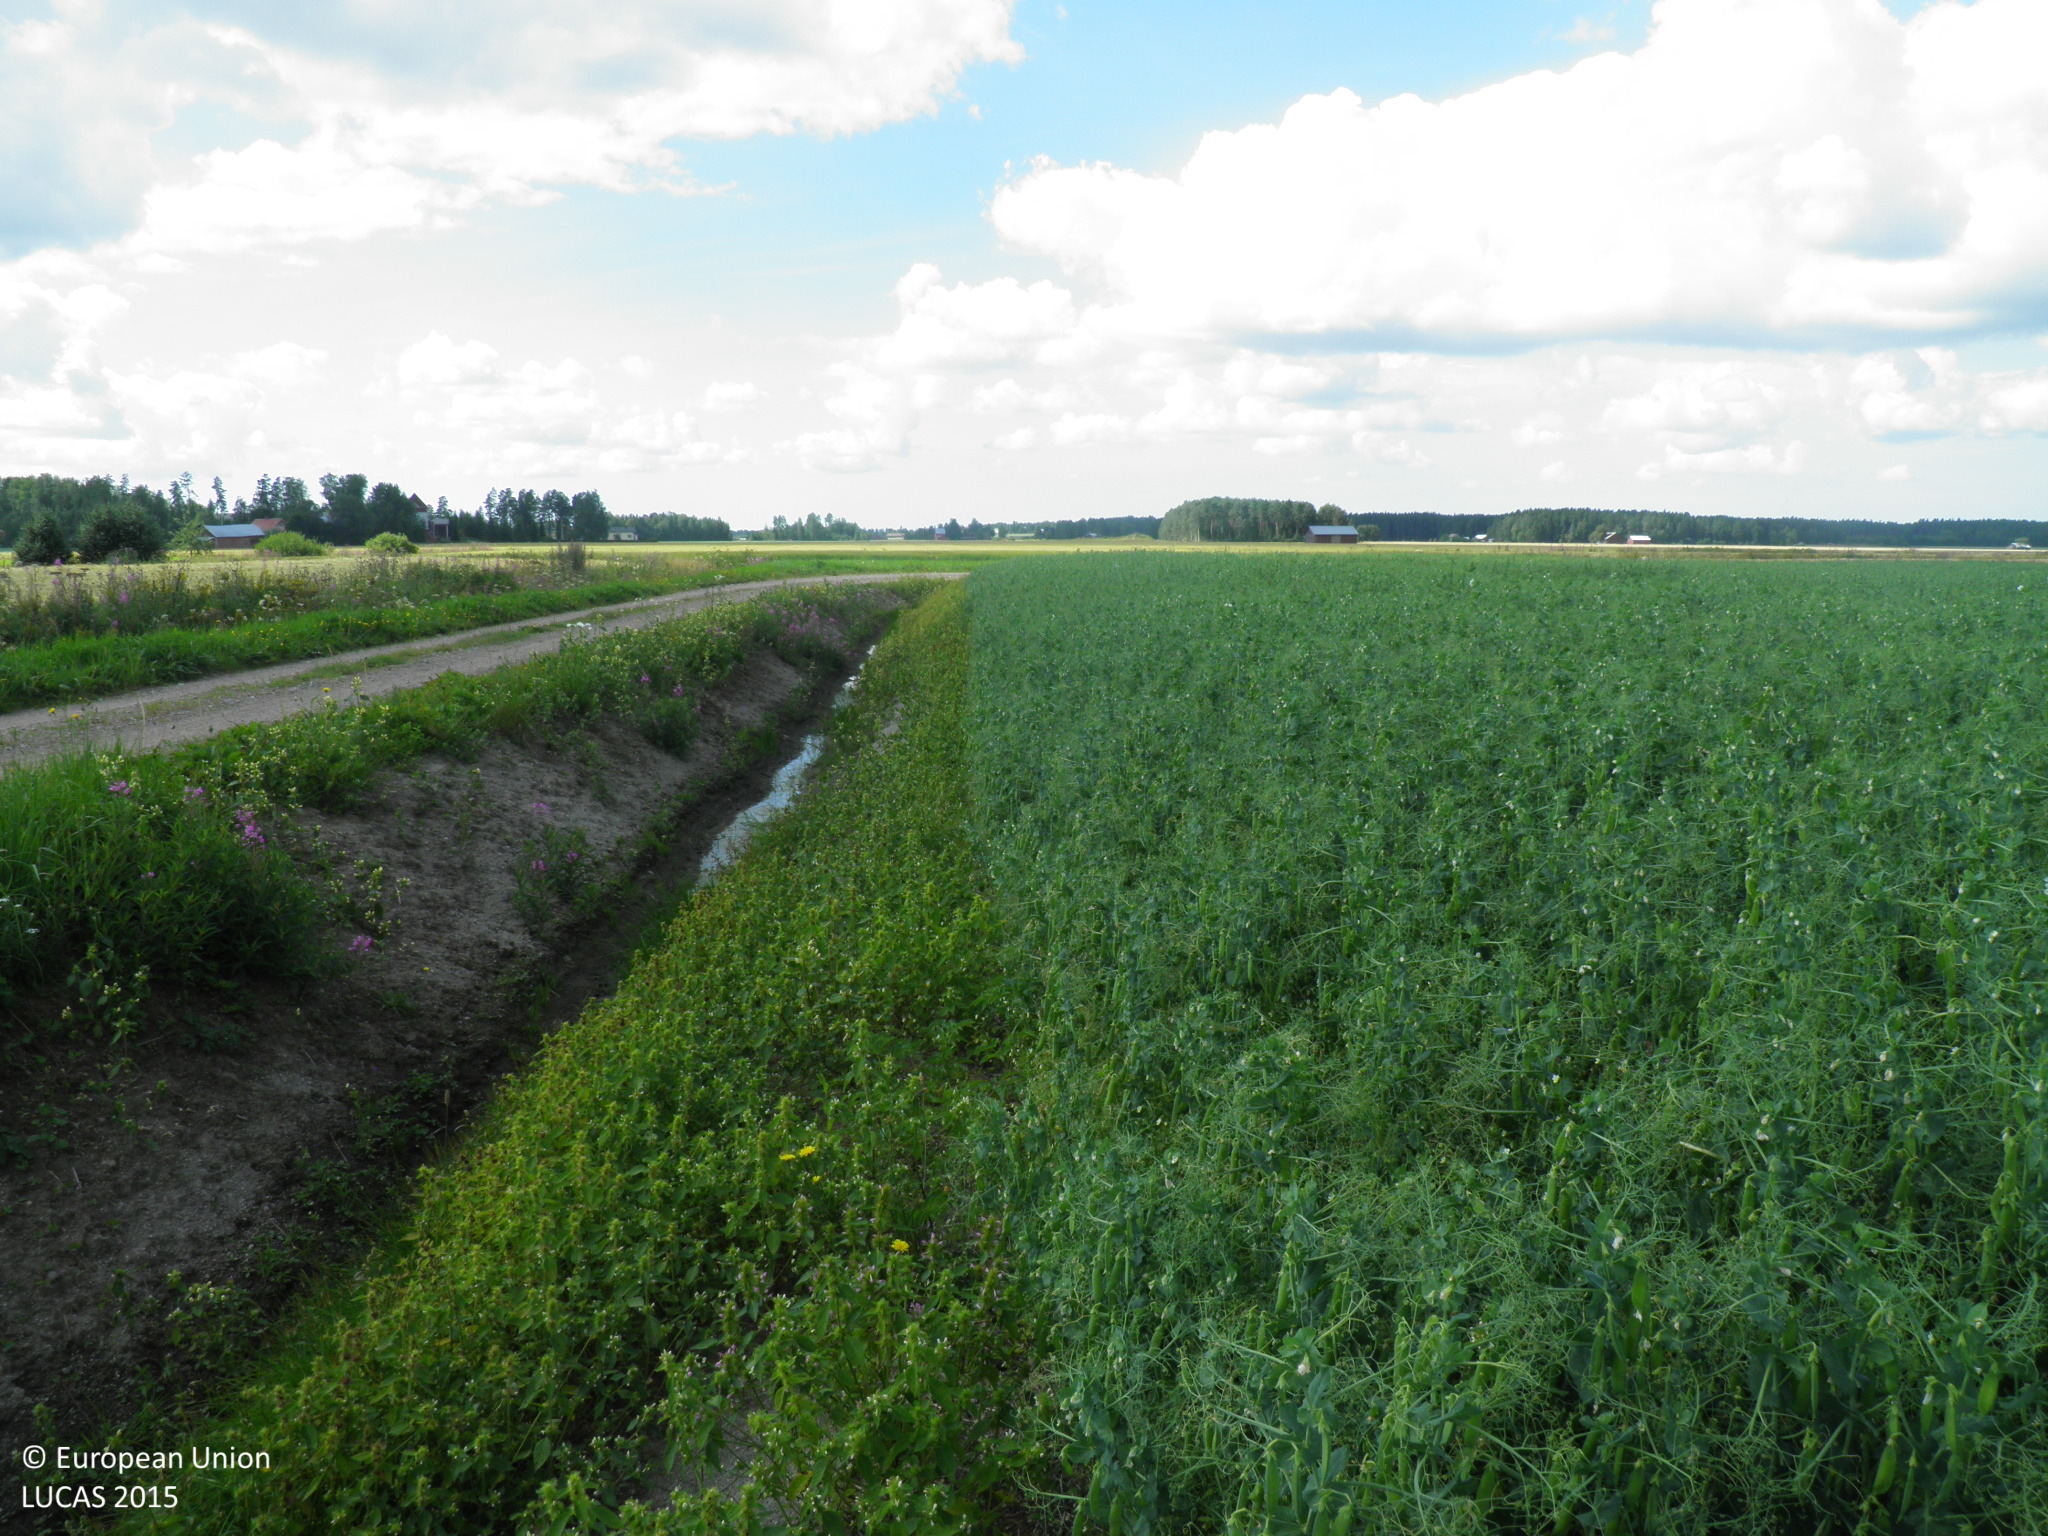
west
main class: Cropland
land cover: Dry pulses
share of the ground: > 75 %
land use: Agriculture (excluding fallow land and kitchen gardens)
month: August
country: FI
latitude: 61.0347
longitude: 21.9993
